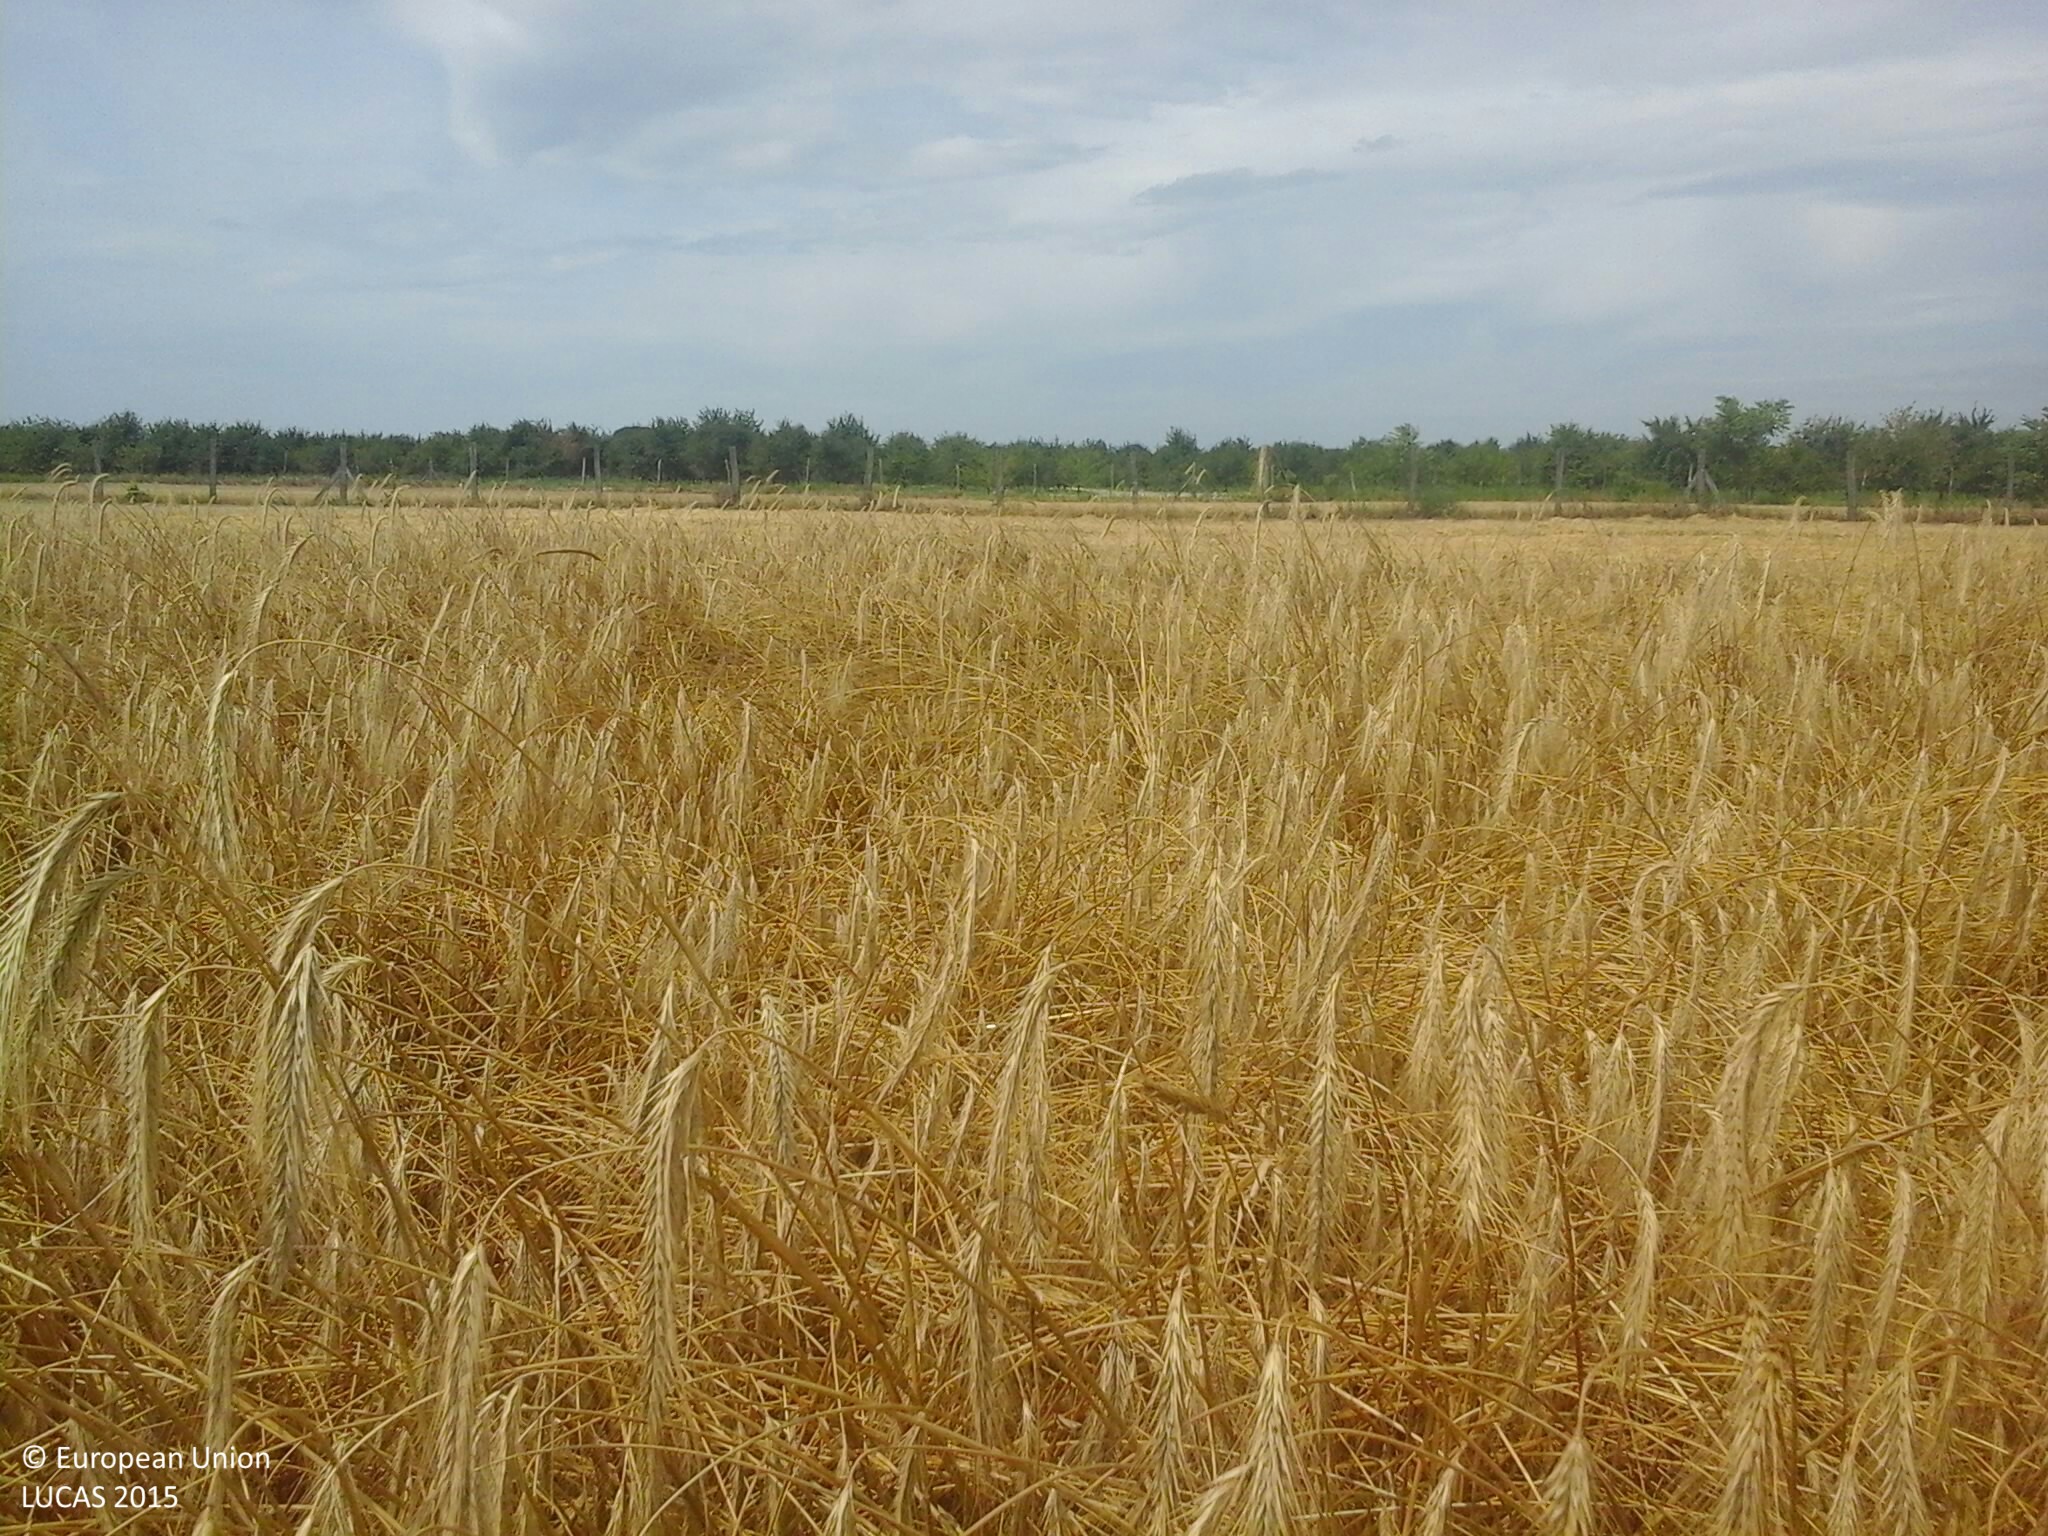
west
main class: Cropland
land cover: Rye
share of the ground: > 75 %
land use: Agriculture (excluding fallow land and kitchen gardens)
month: July
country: HU
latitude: 47.1867
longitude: 18.9769
